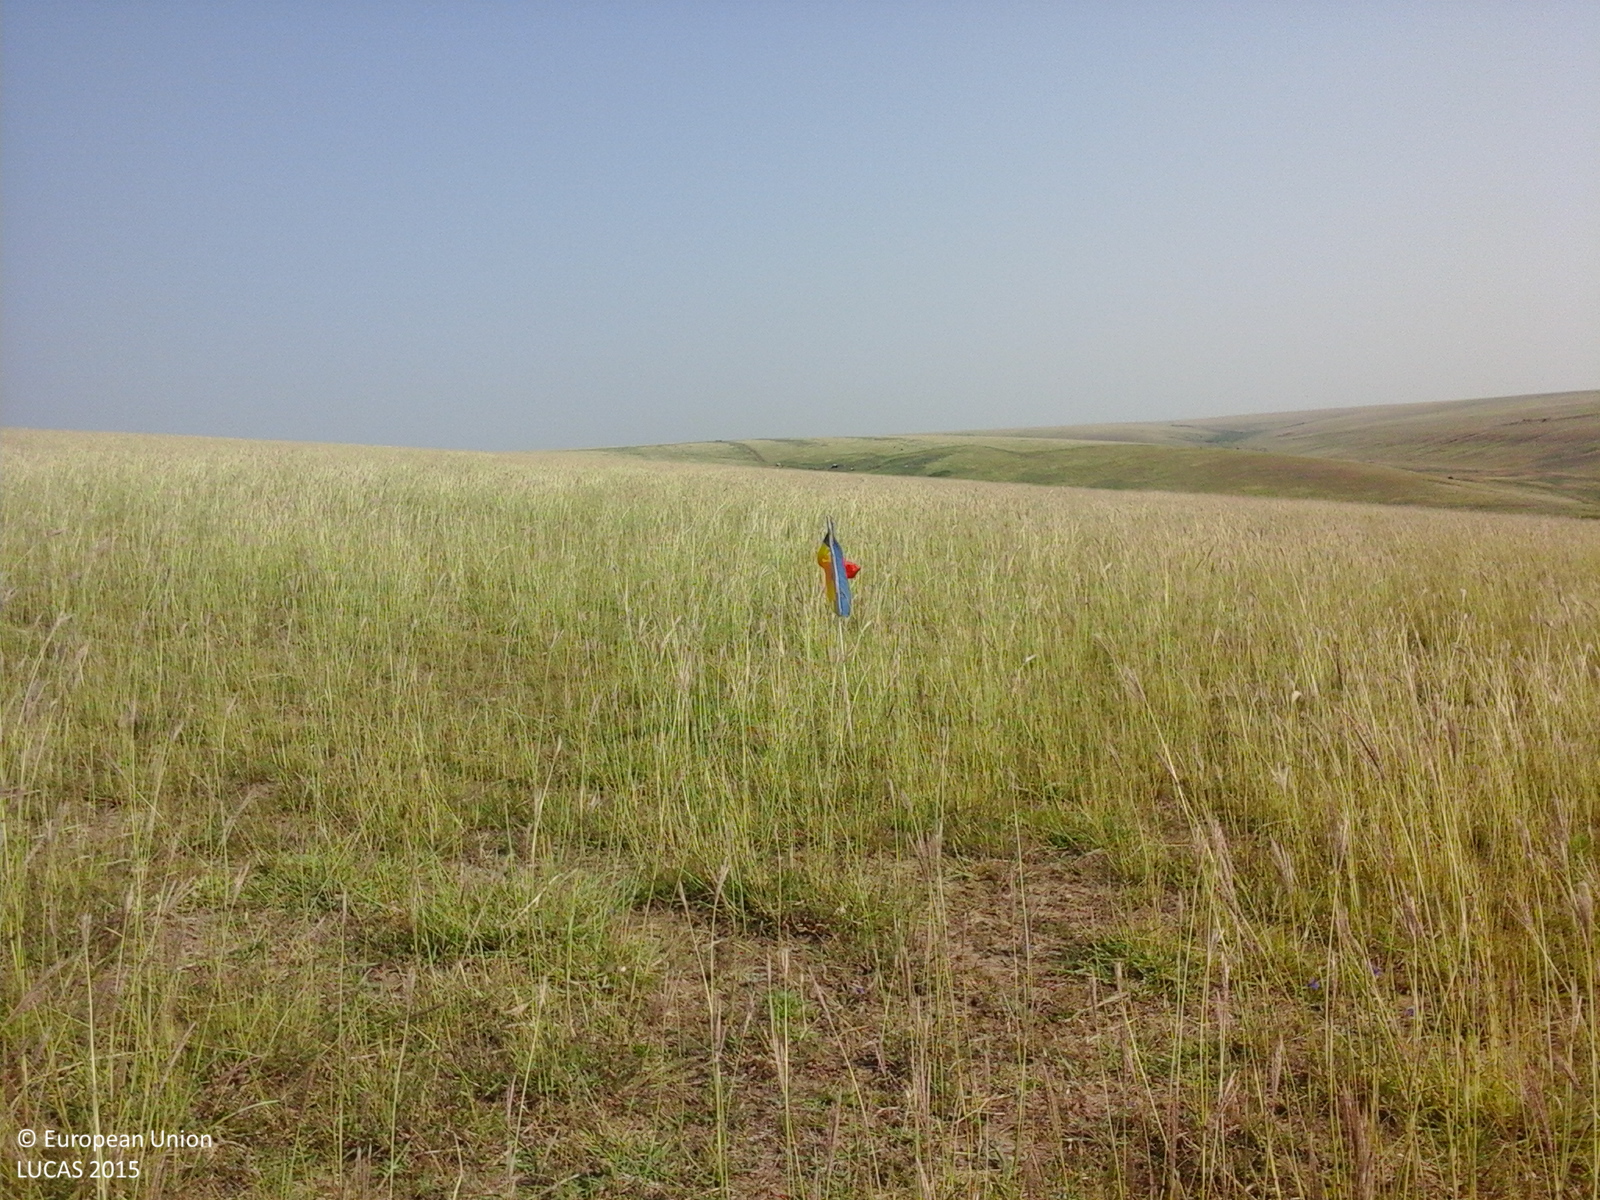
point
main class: Grassland
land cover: Grassland without tree/shrub cover
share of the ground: > 75 %
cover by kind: herbaceous plants 100 %
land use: Agriculture (excluding fallow land and kitchen gardens)
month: July
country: RO
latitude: 45.6130
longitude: 27.9281
